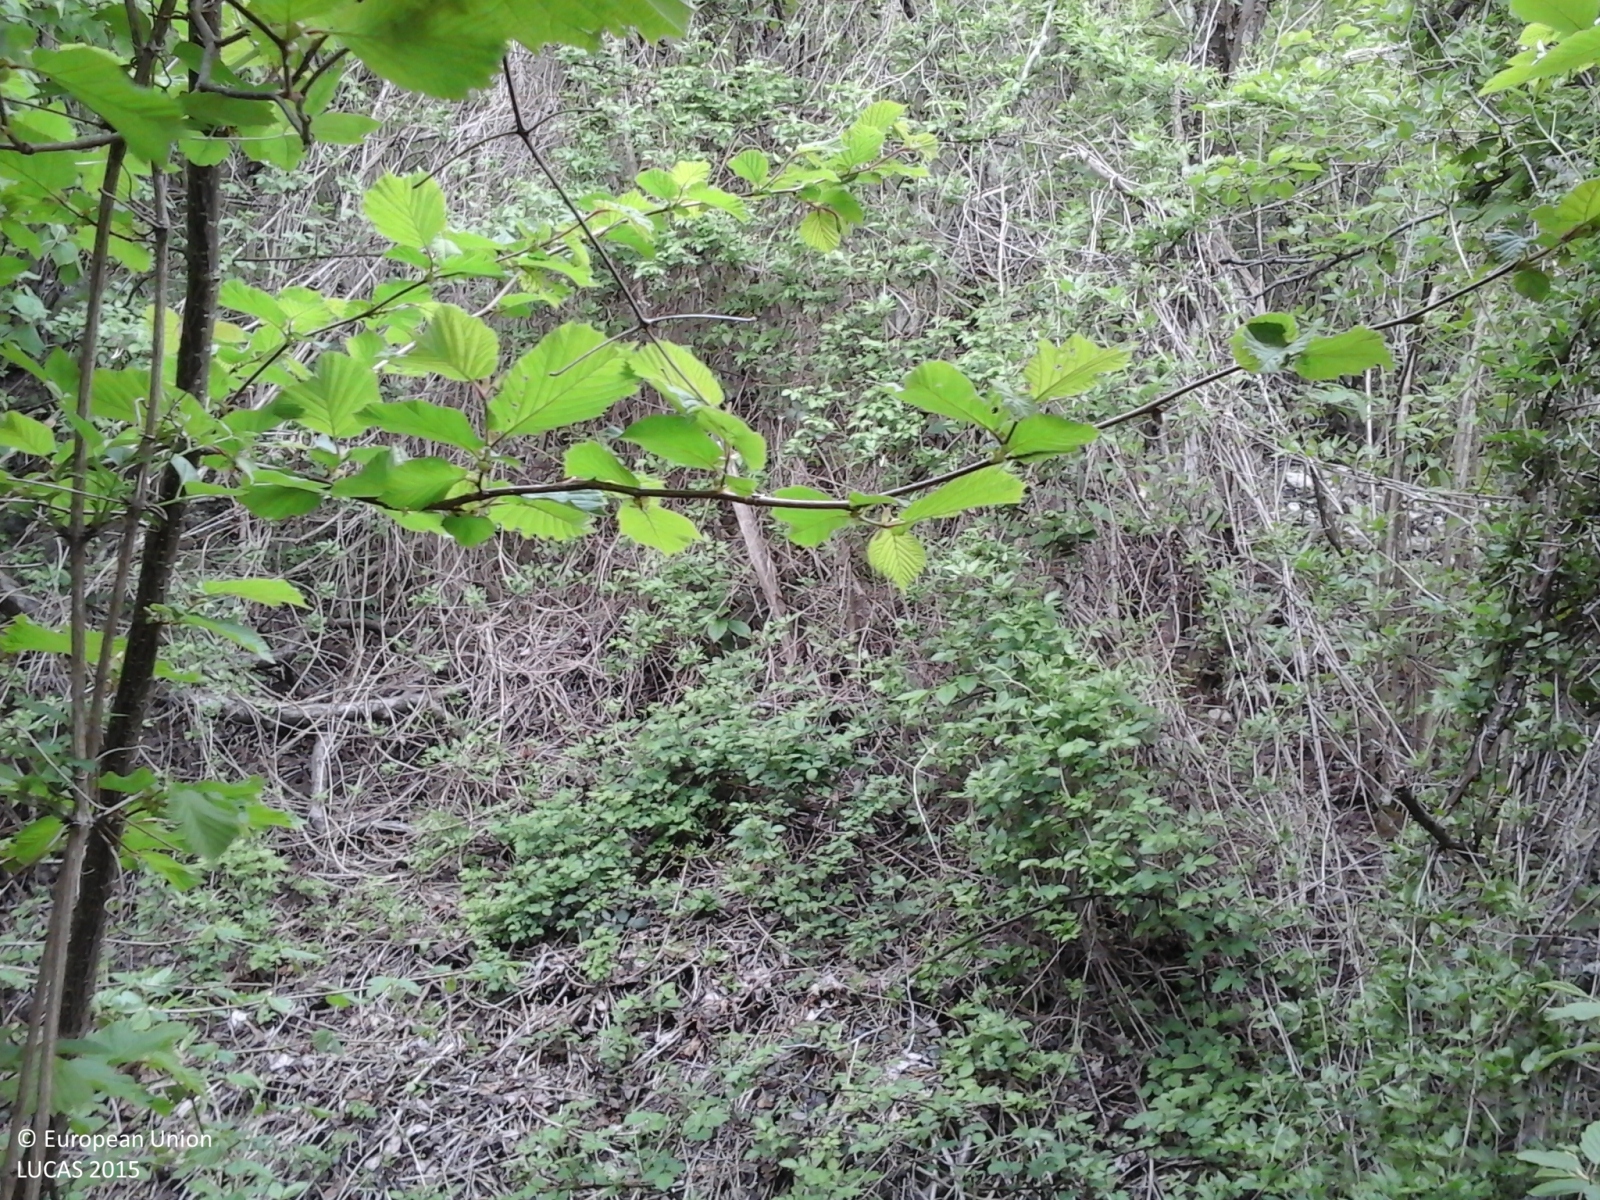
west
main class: Woodland
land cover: Broadleaved woodland
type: mesophytic deciduous forest
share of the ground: > 75 %
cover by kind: broadleaved forest trees 70 %, shrubs 30 %
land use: Forestry
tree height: > 5 m
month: May
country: IT
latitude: 44.6373
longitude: 9.3836
